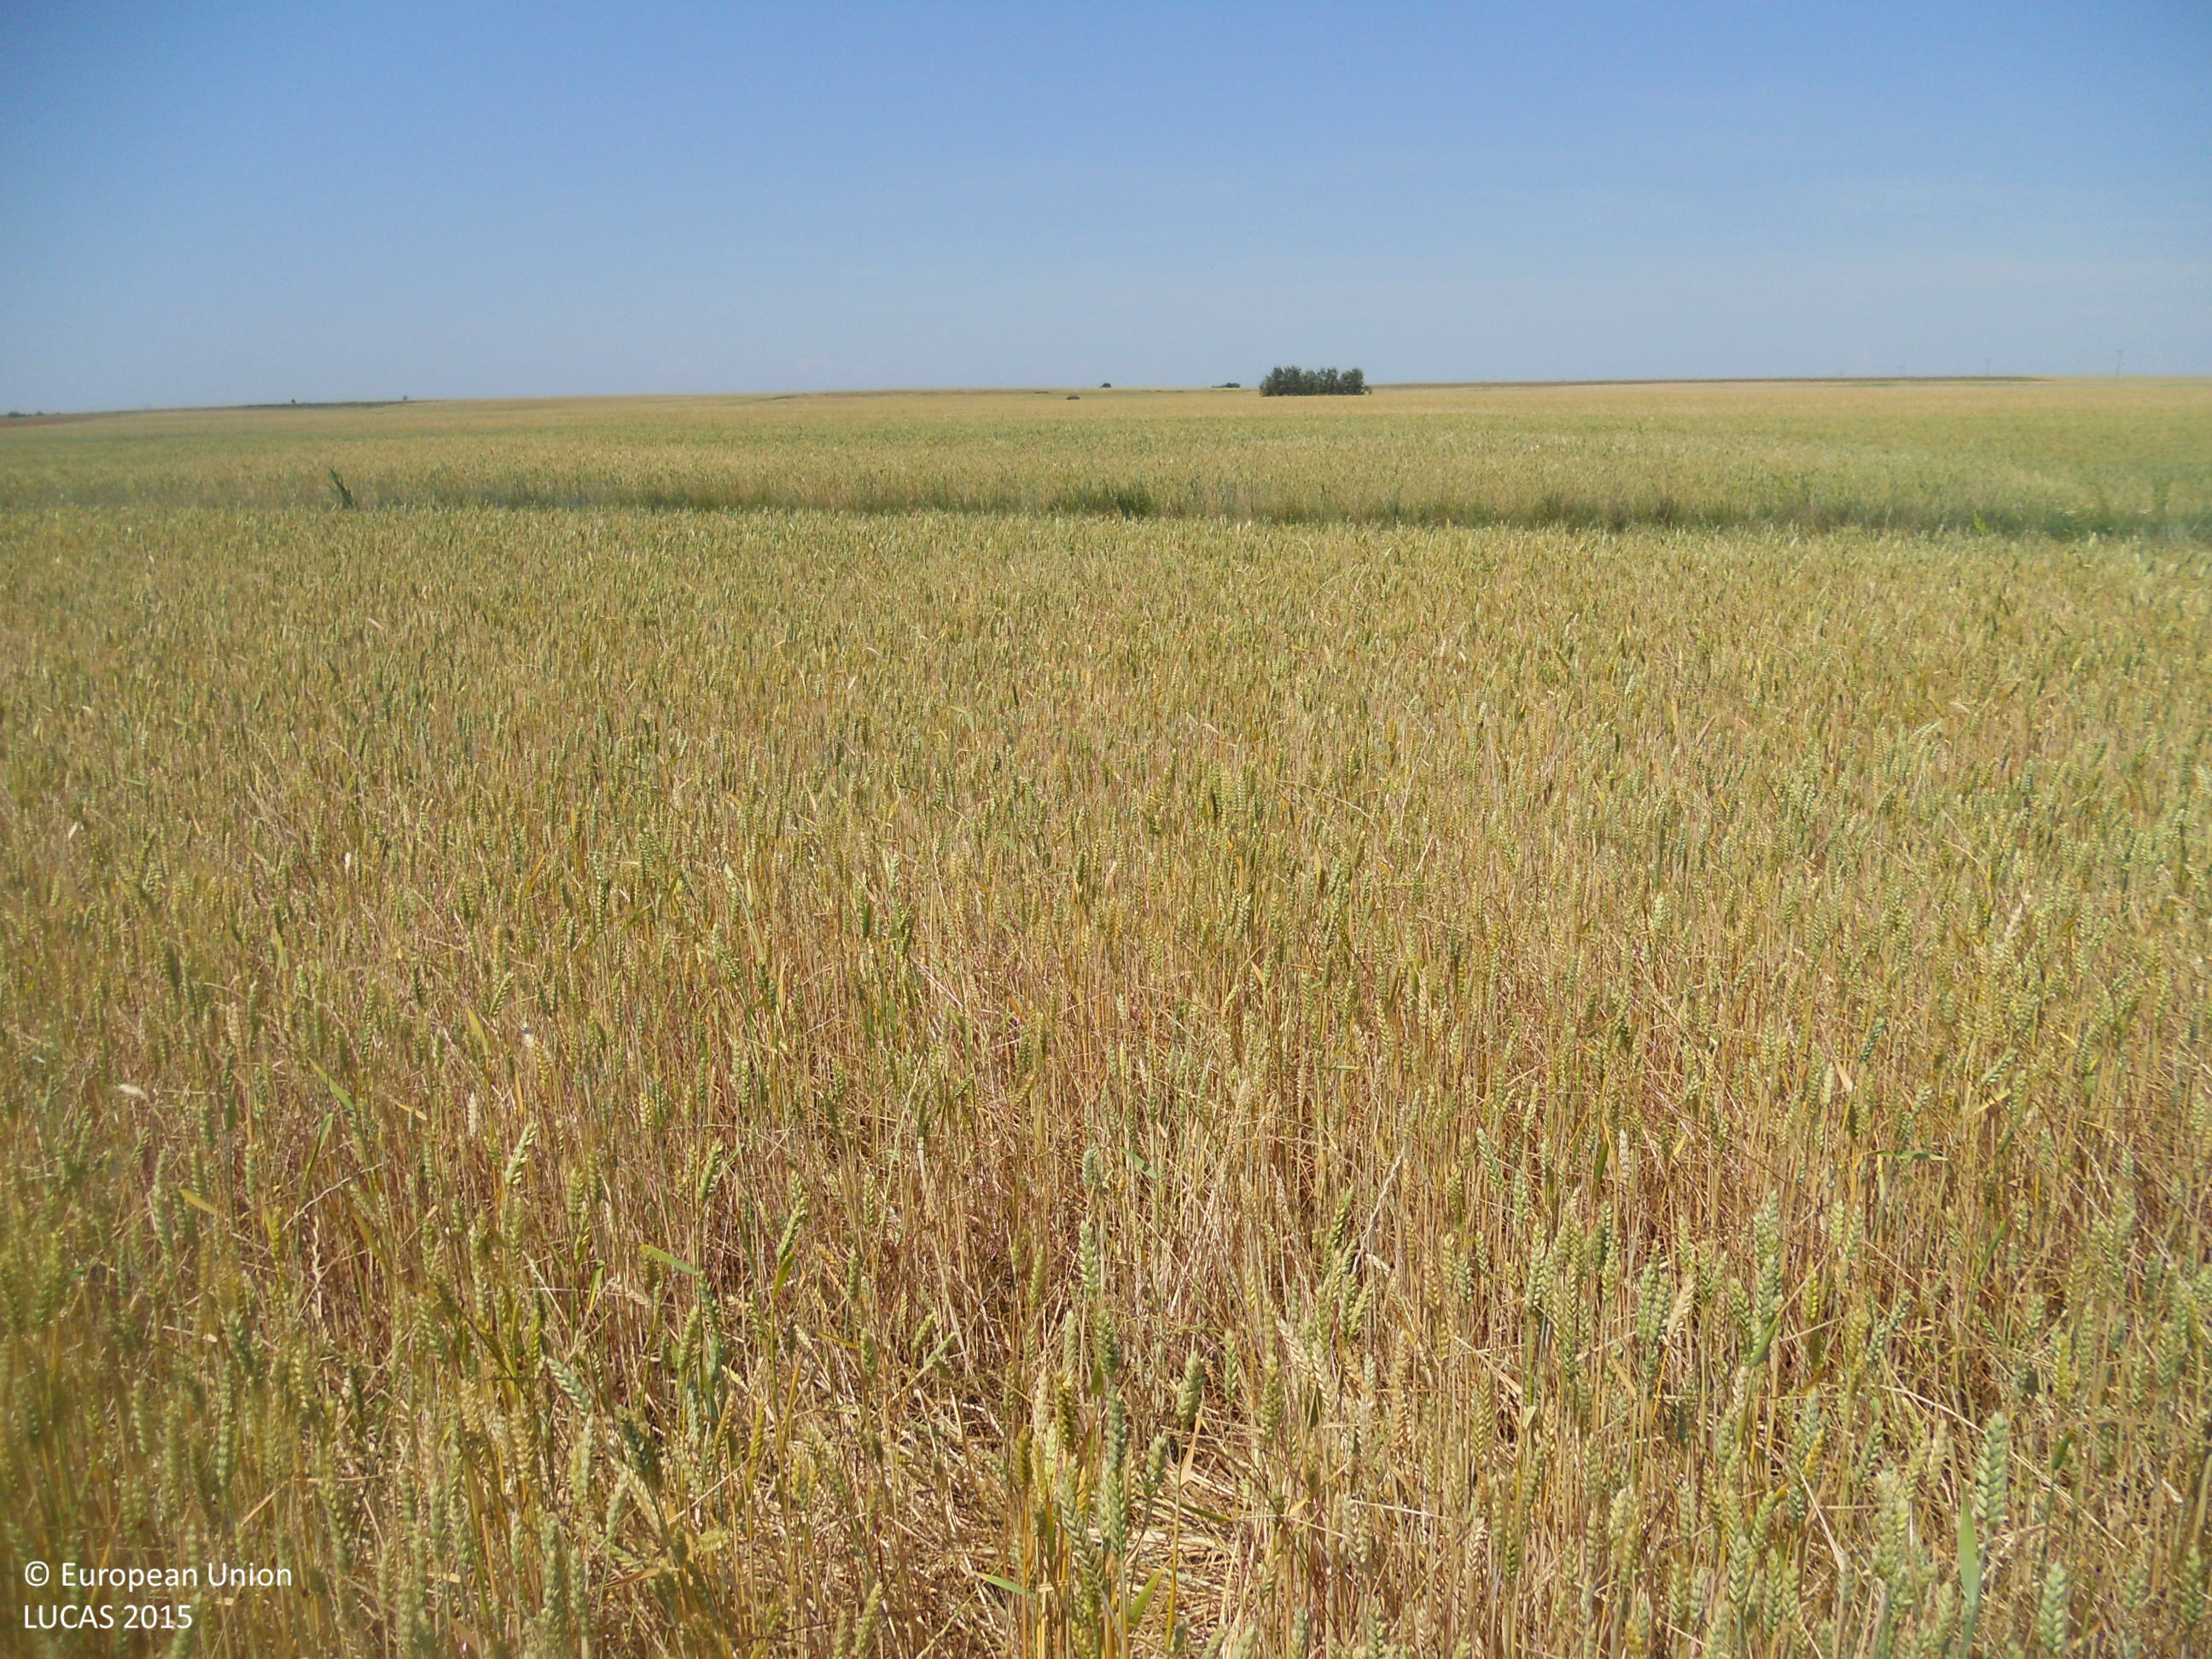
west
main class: Cropland
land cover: Common wheat
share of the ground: > 75 %
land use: Agriculture (excluding fallow land and kitchen gardens)
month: June
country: ES
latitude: 42.2294
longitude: -5.3425
